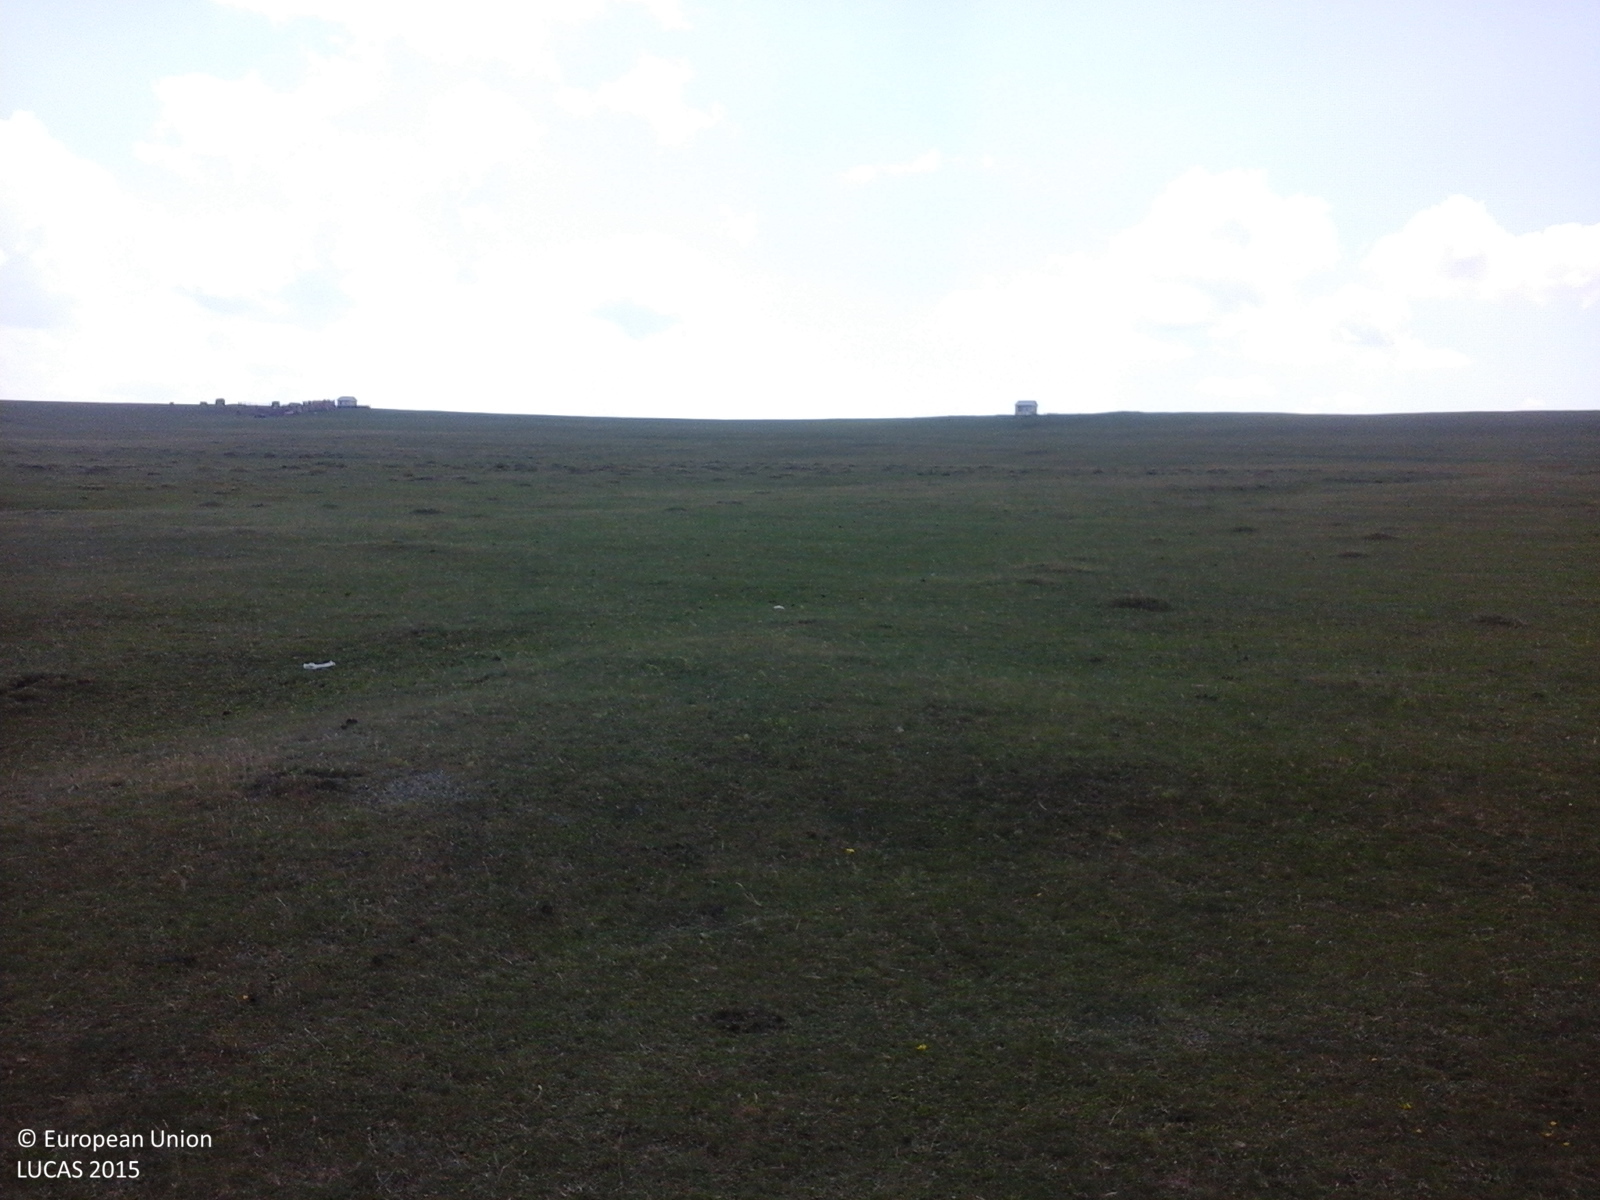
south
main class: Grassland
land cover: Grassland without tree/shrub cover
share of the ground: > 75 %
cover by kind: herbaceous plants 100 %
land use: Agriculture (excluding fallow land and kitchen gardens)
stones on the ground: < 10 %
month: June
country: RO
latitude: 48.1491
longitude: 26.5878
